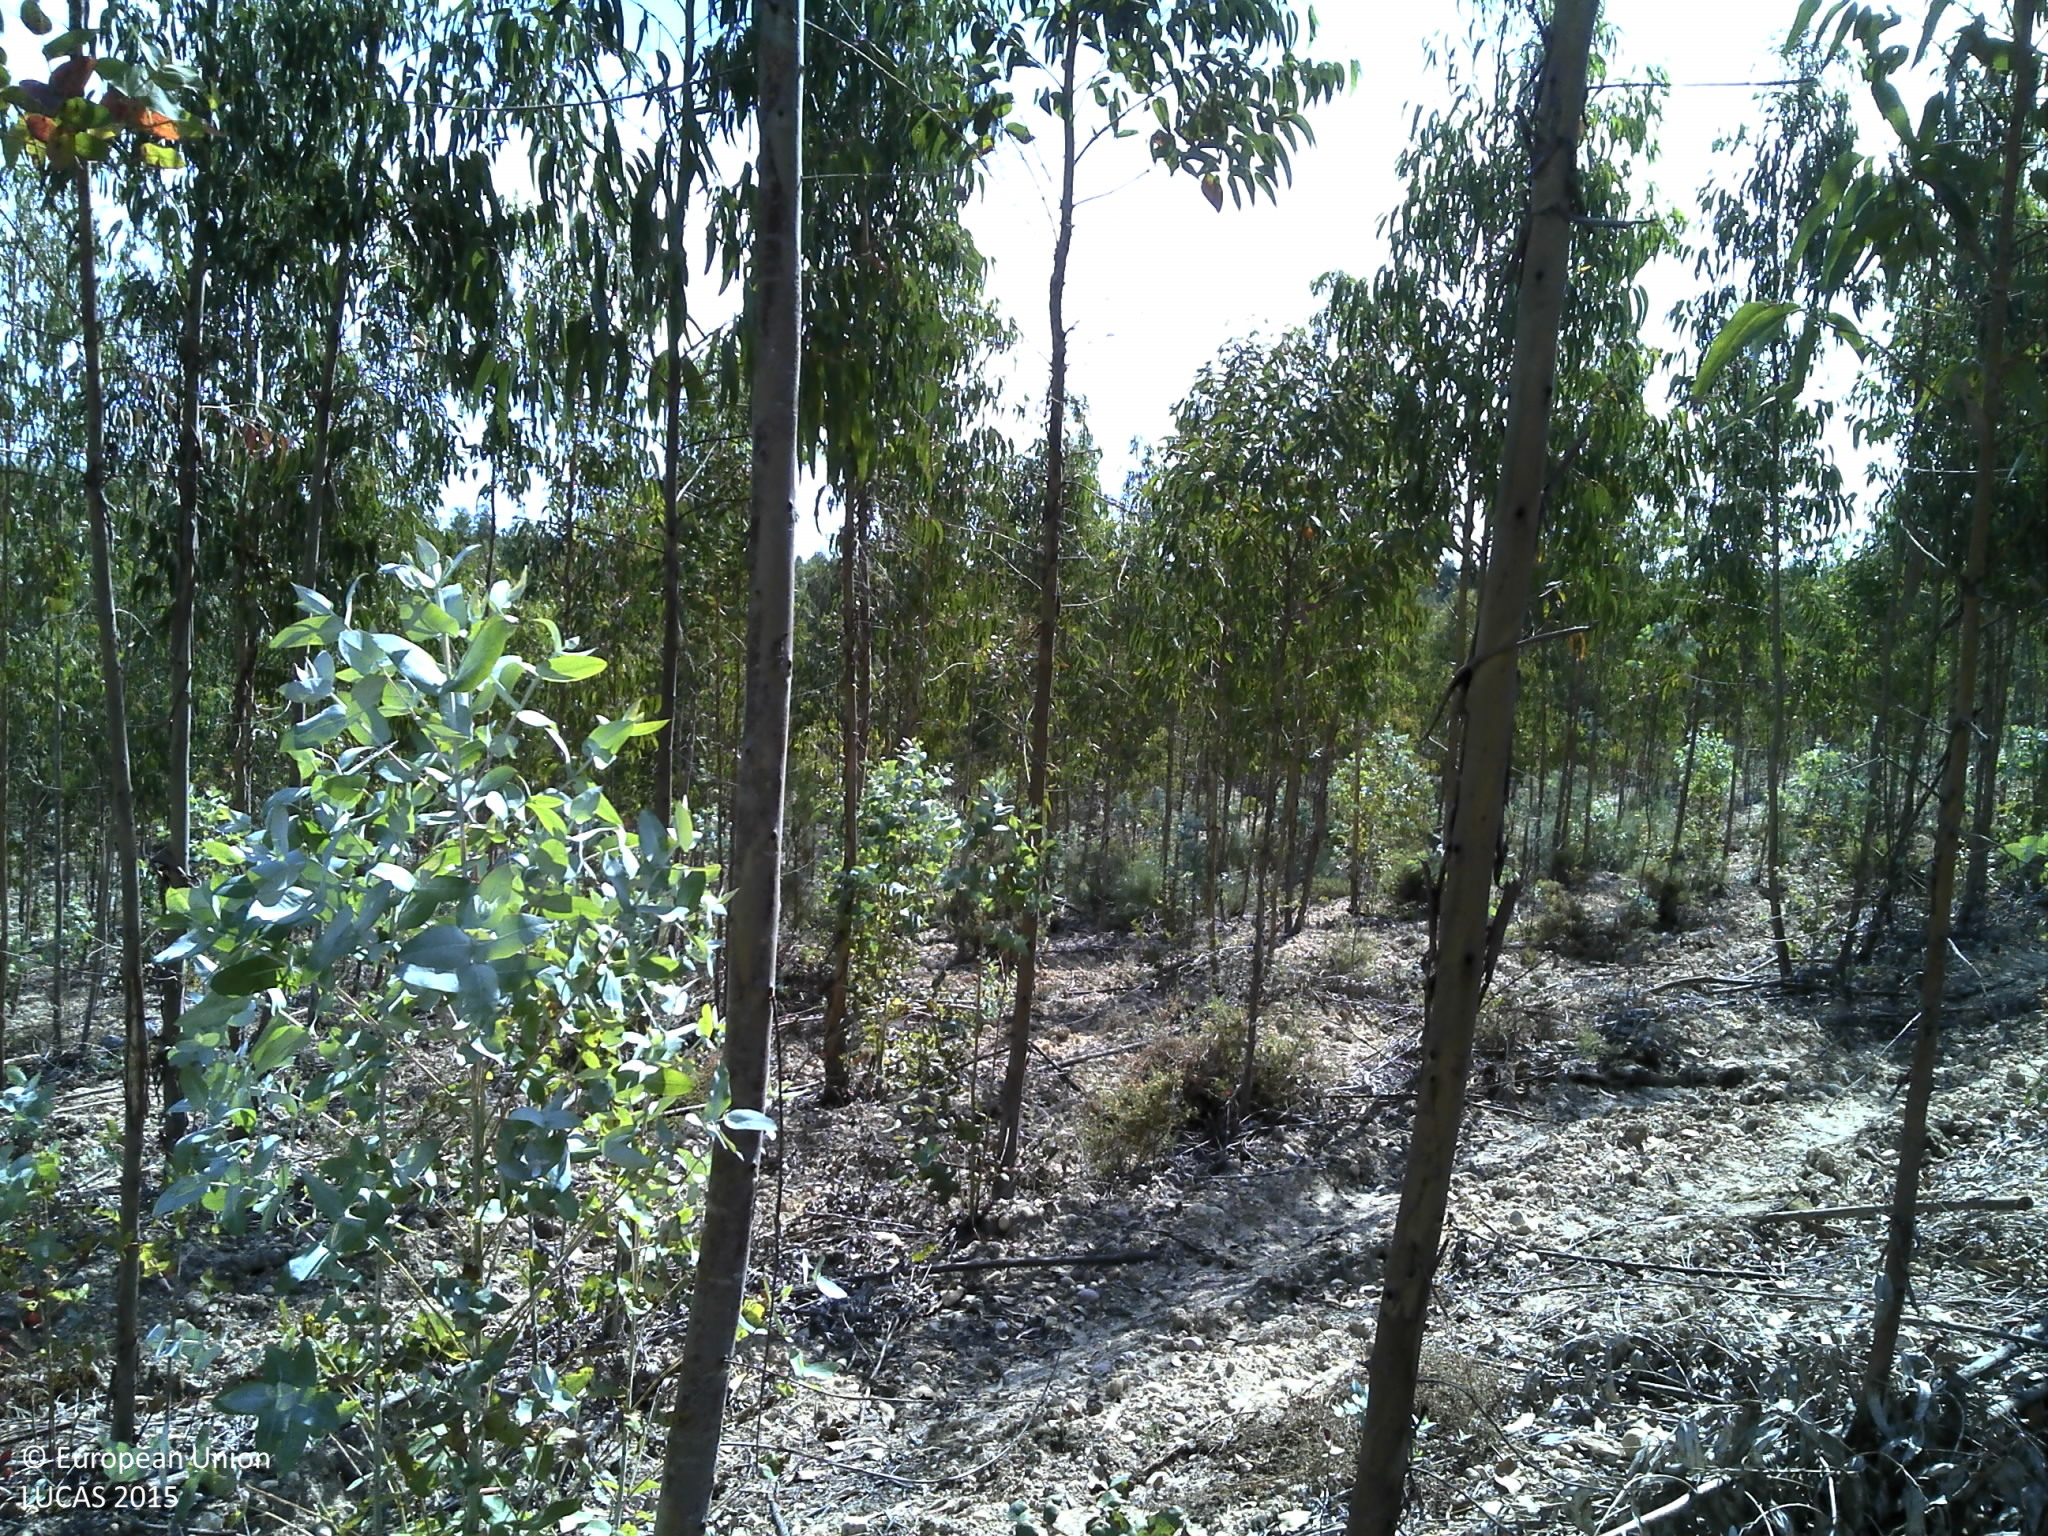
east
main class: Woodland
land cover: Broadleaved woodland
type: exotic forest
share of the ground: 50 - 75 %
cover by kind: broadleaved forest trees 50 %, unconsolidated bare surface 50 %
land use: Forestry
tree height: > 5 m
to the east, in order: Broadleaved woodland; Other bare soil; Broadleaved woodland; Tracks; Broadleaved woodland; Tracks; Broadleaved woodland
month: May
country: PT
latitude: 39.2776
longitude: -7.9640
